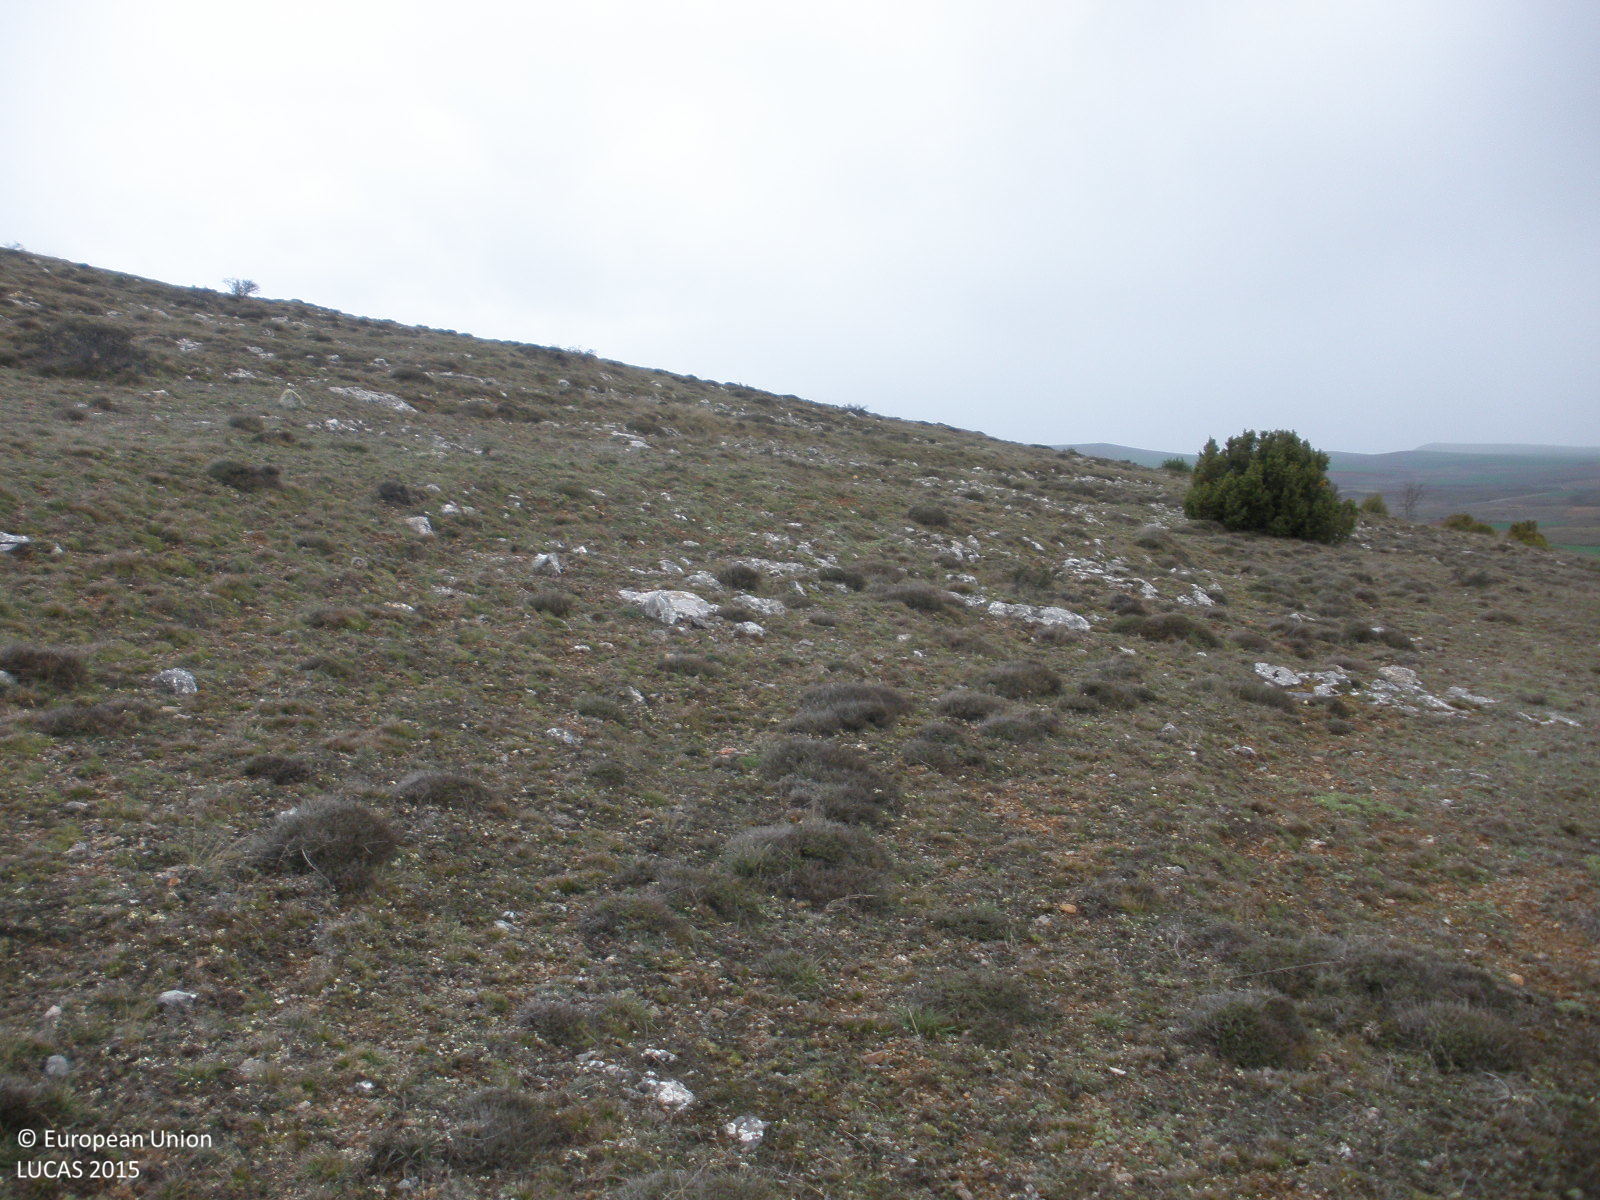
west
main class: Shrubland
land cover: Shrubland without tree cover
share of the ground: 25 - 50 %
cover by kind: herbaceous plants 50 %, shrubs 30 %, consolidated bare surface 20 %
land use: Semi-natural and natural areas not in use
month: April
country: ES
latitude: 40.7494
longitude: -1.0886
